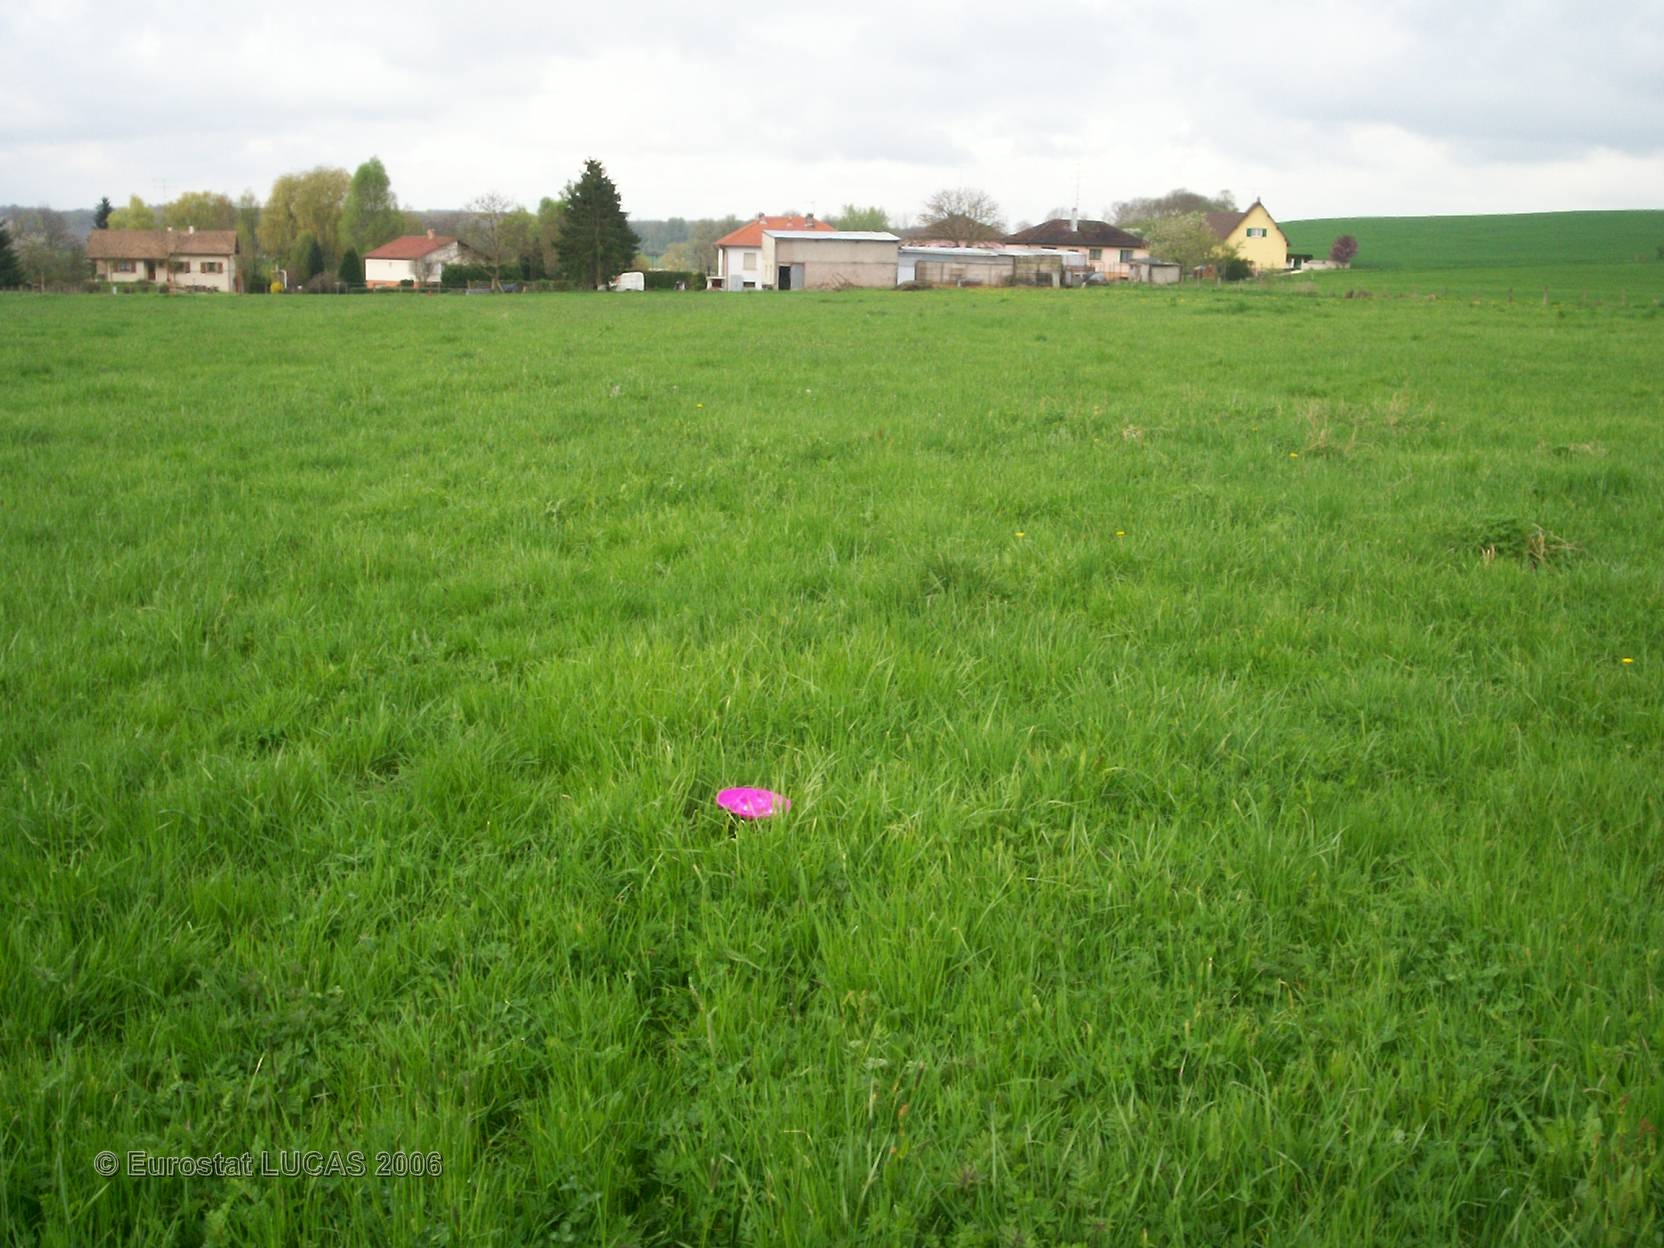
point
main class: Grassland
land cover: Grassland without tree/shrub cover
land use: Agriculture (excluding fallow land and kitchen gardens)
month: April
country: FR
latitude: 48.8058
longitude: 6.7462
